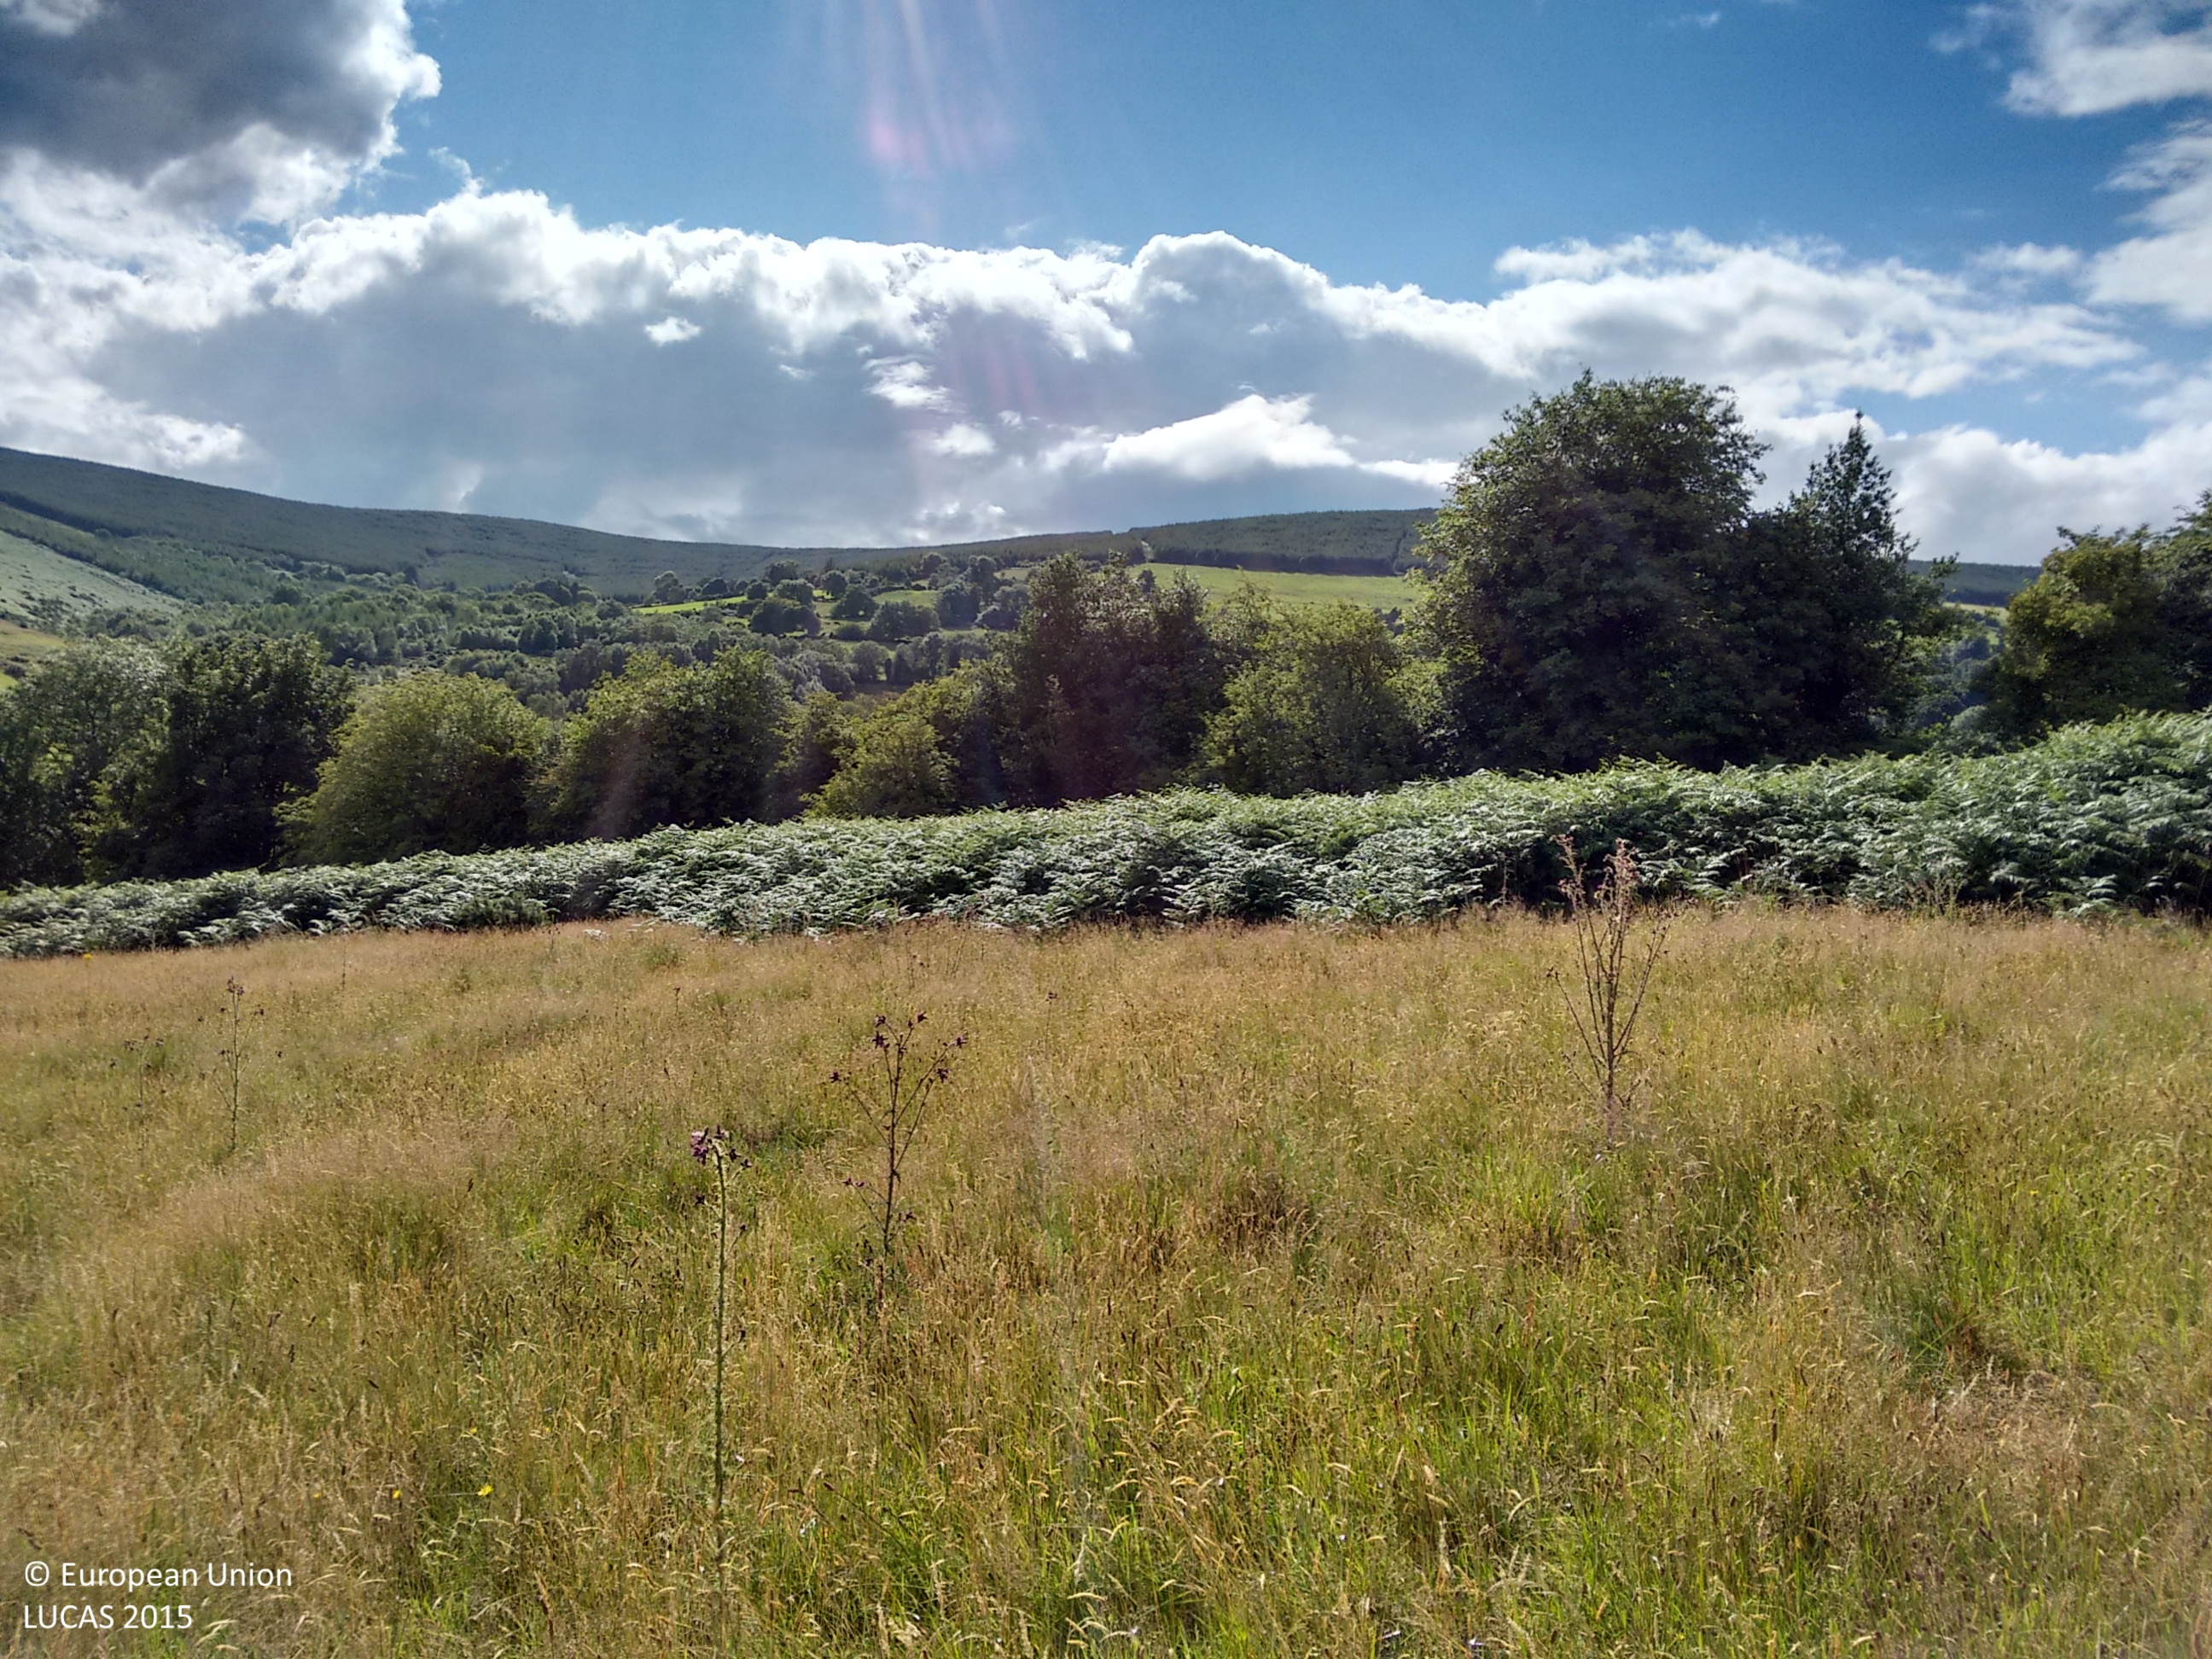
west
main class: Grassland
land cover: Grassland without tree/shrub cover
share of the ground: > 75 %
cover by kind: herbaceous plants 100 %
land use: Agriculture (excluding fallow land and kitchen gardens)
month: July
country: IE
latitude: 52.8365
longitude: -6.4399
